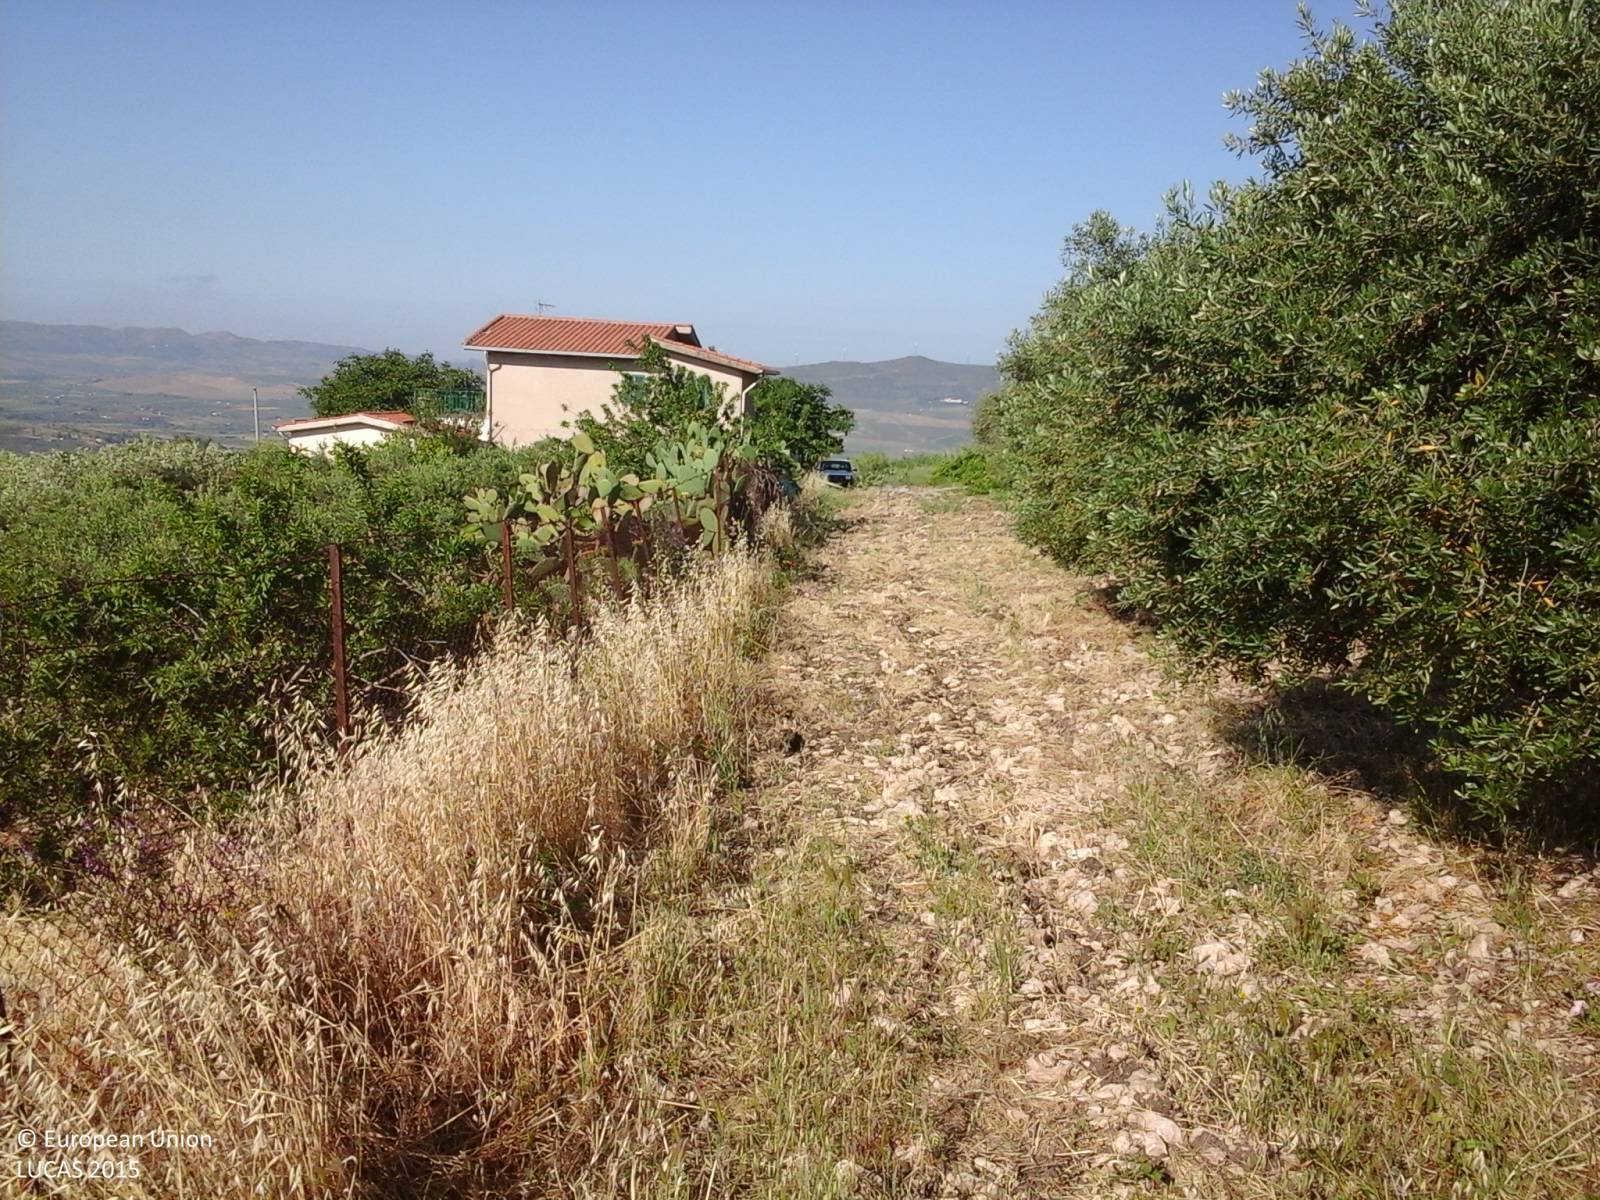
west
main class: Grassland
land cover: Grassland with sparse tree/shrub cover
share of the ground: > 75 %
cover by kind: herbaceous plants 95 %, broadleaved forest trees 5 %
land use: Abandoned areas
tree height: > 5 m
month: June
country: IT
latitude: 37.9859
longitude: 13.1540
